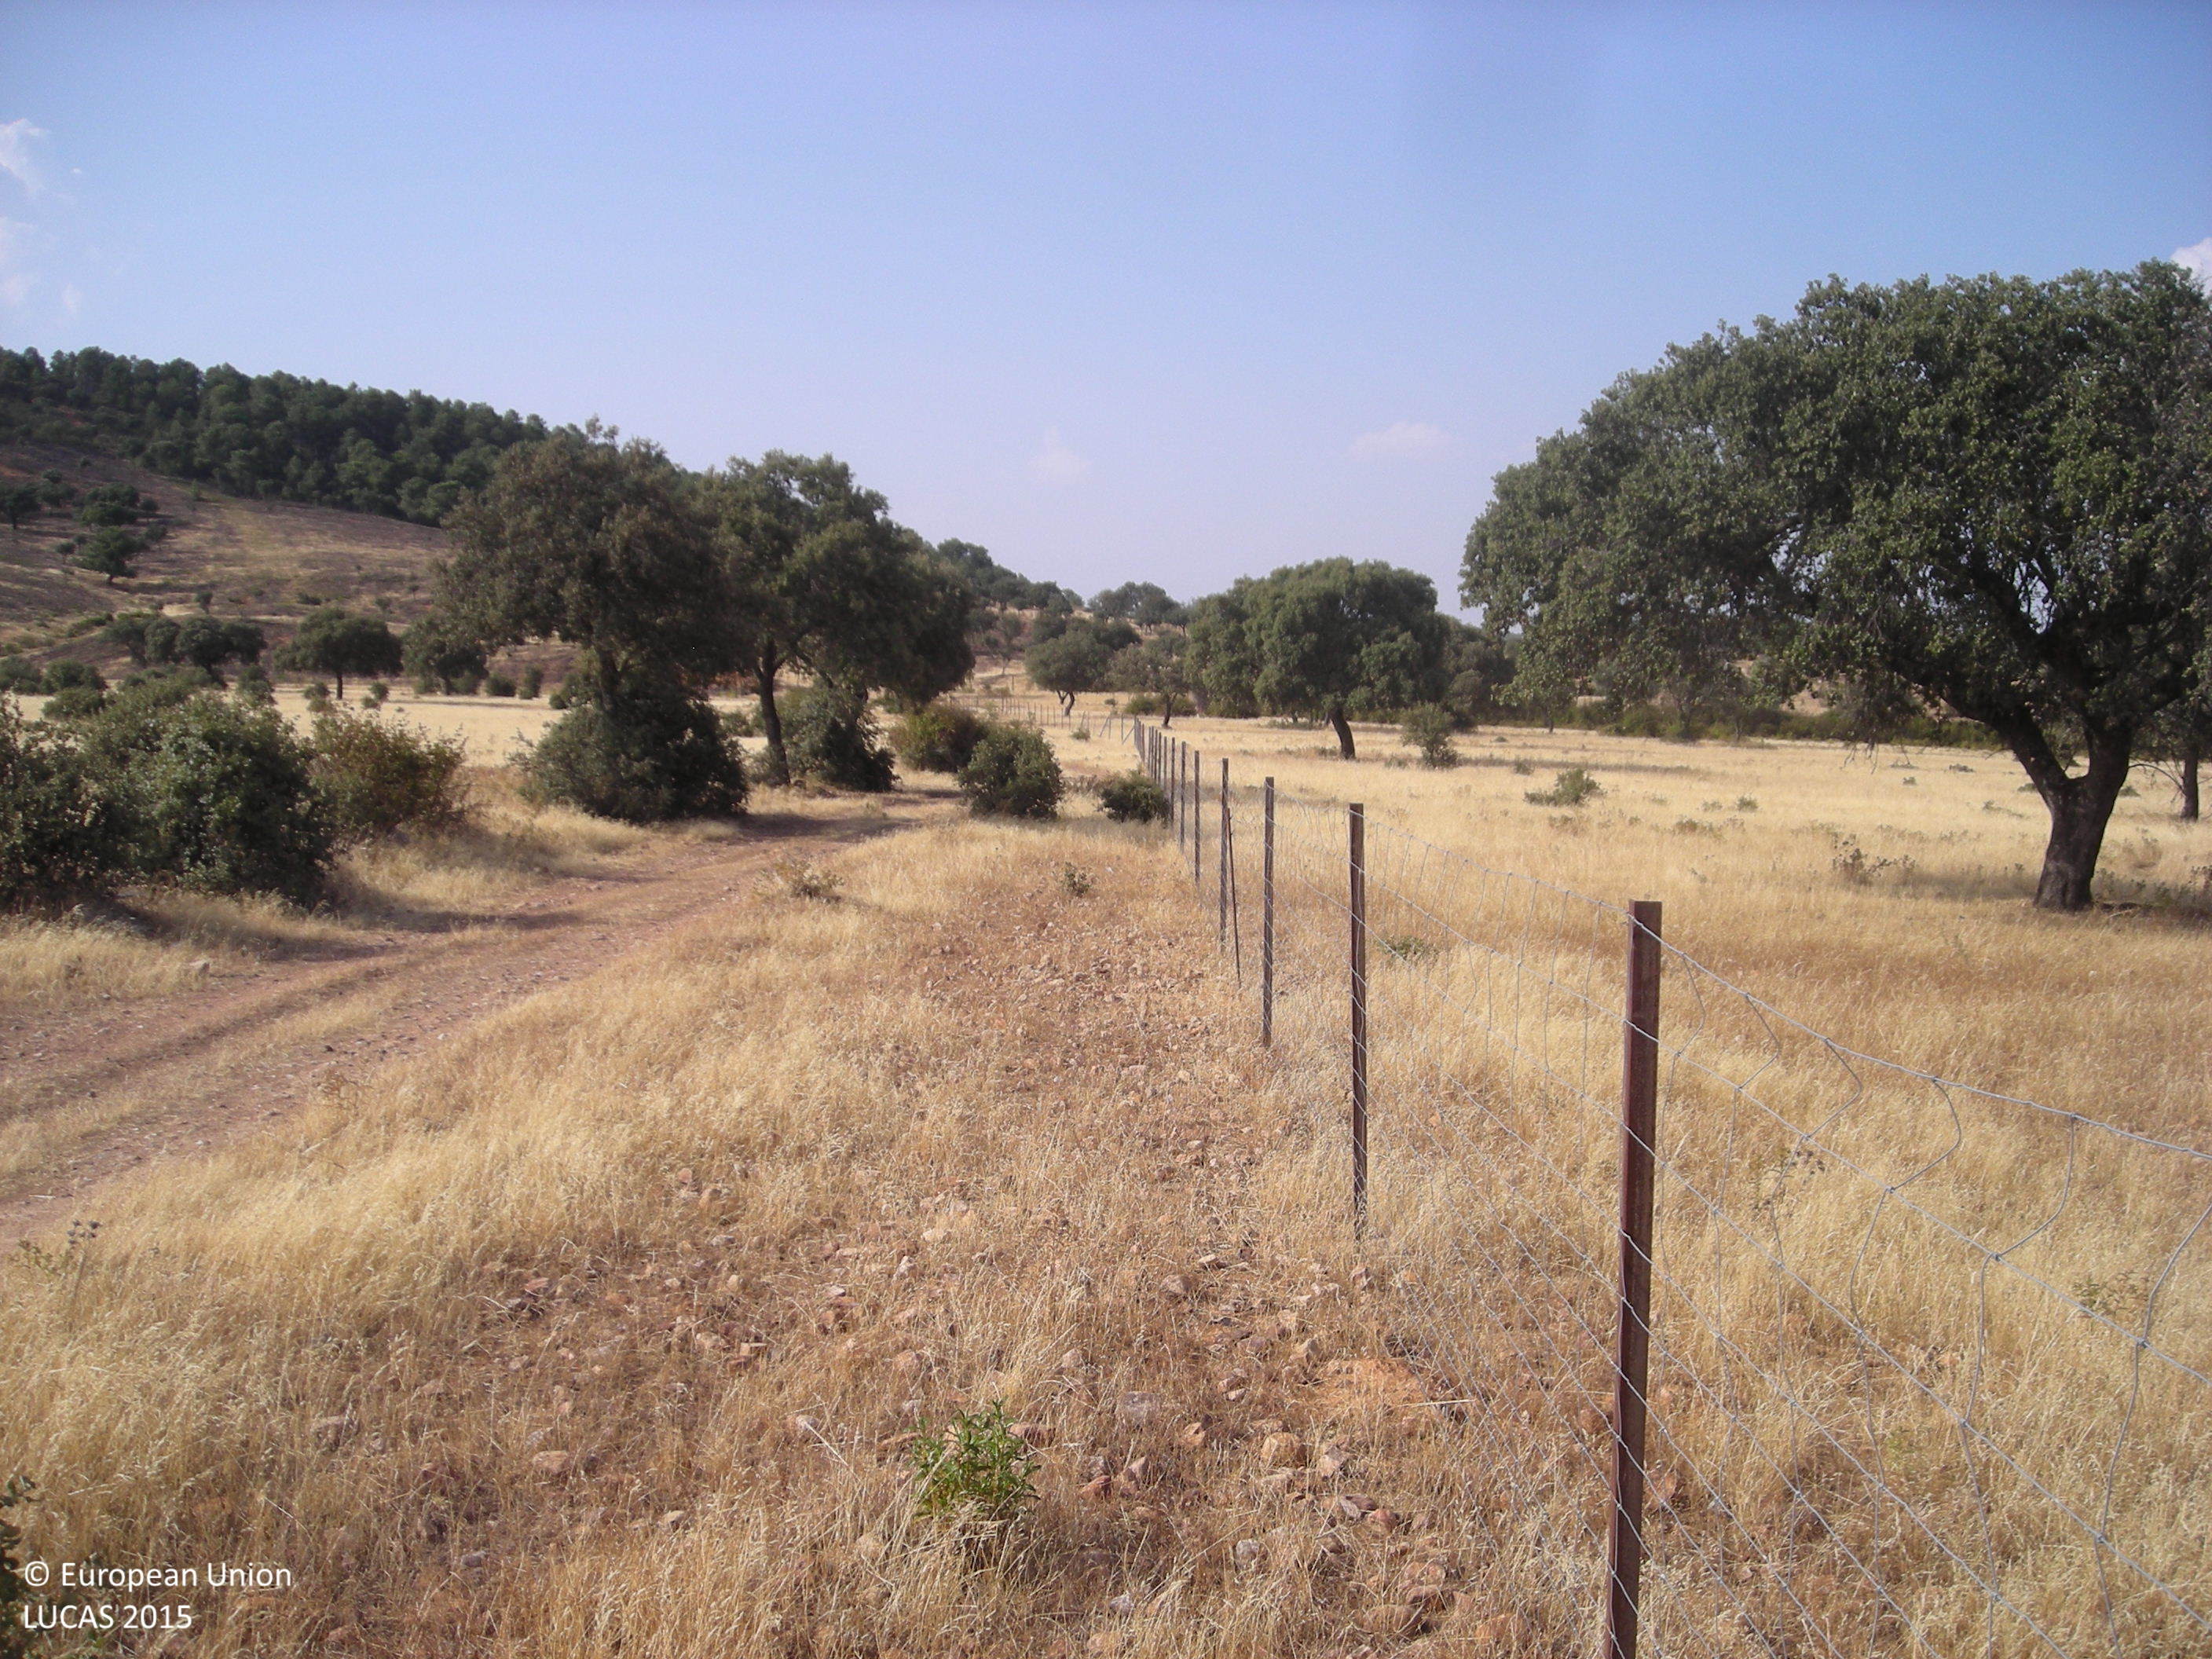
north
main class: Grassland
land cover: Grassland without tree/shrub cover
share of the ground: > 75 %
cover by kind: herbaceous plants 100 %
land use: Agriculture (excluding fallow land and kitchen gardens)
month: July
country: ES
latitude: 39.2566
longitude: -5.3305
